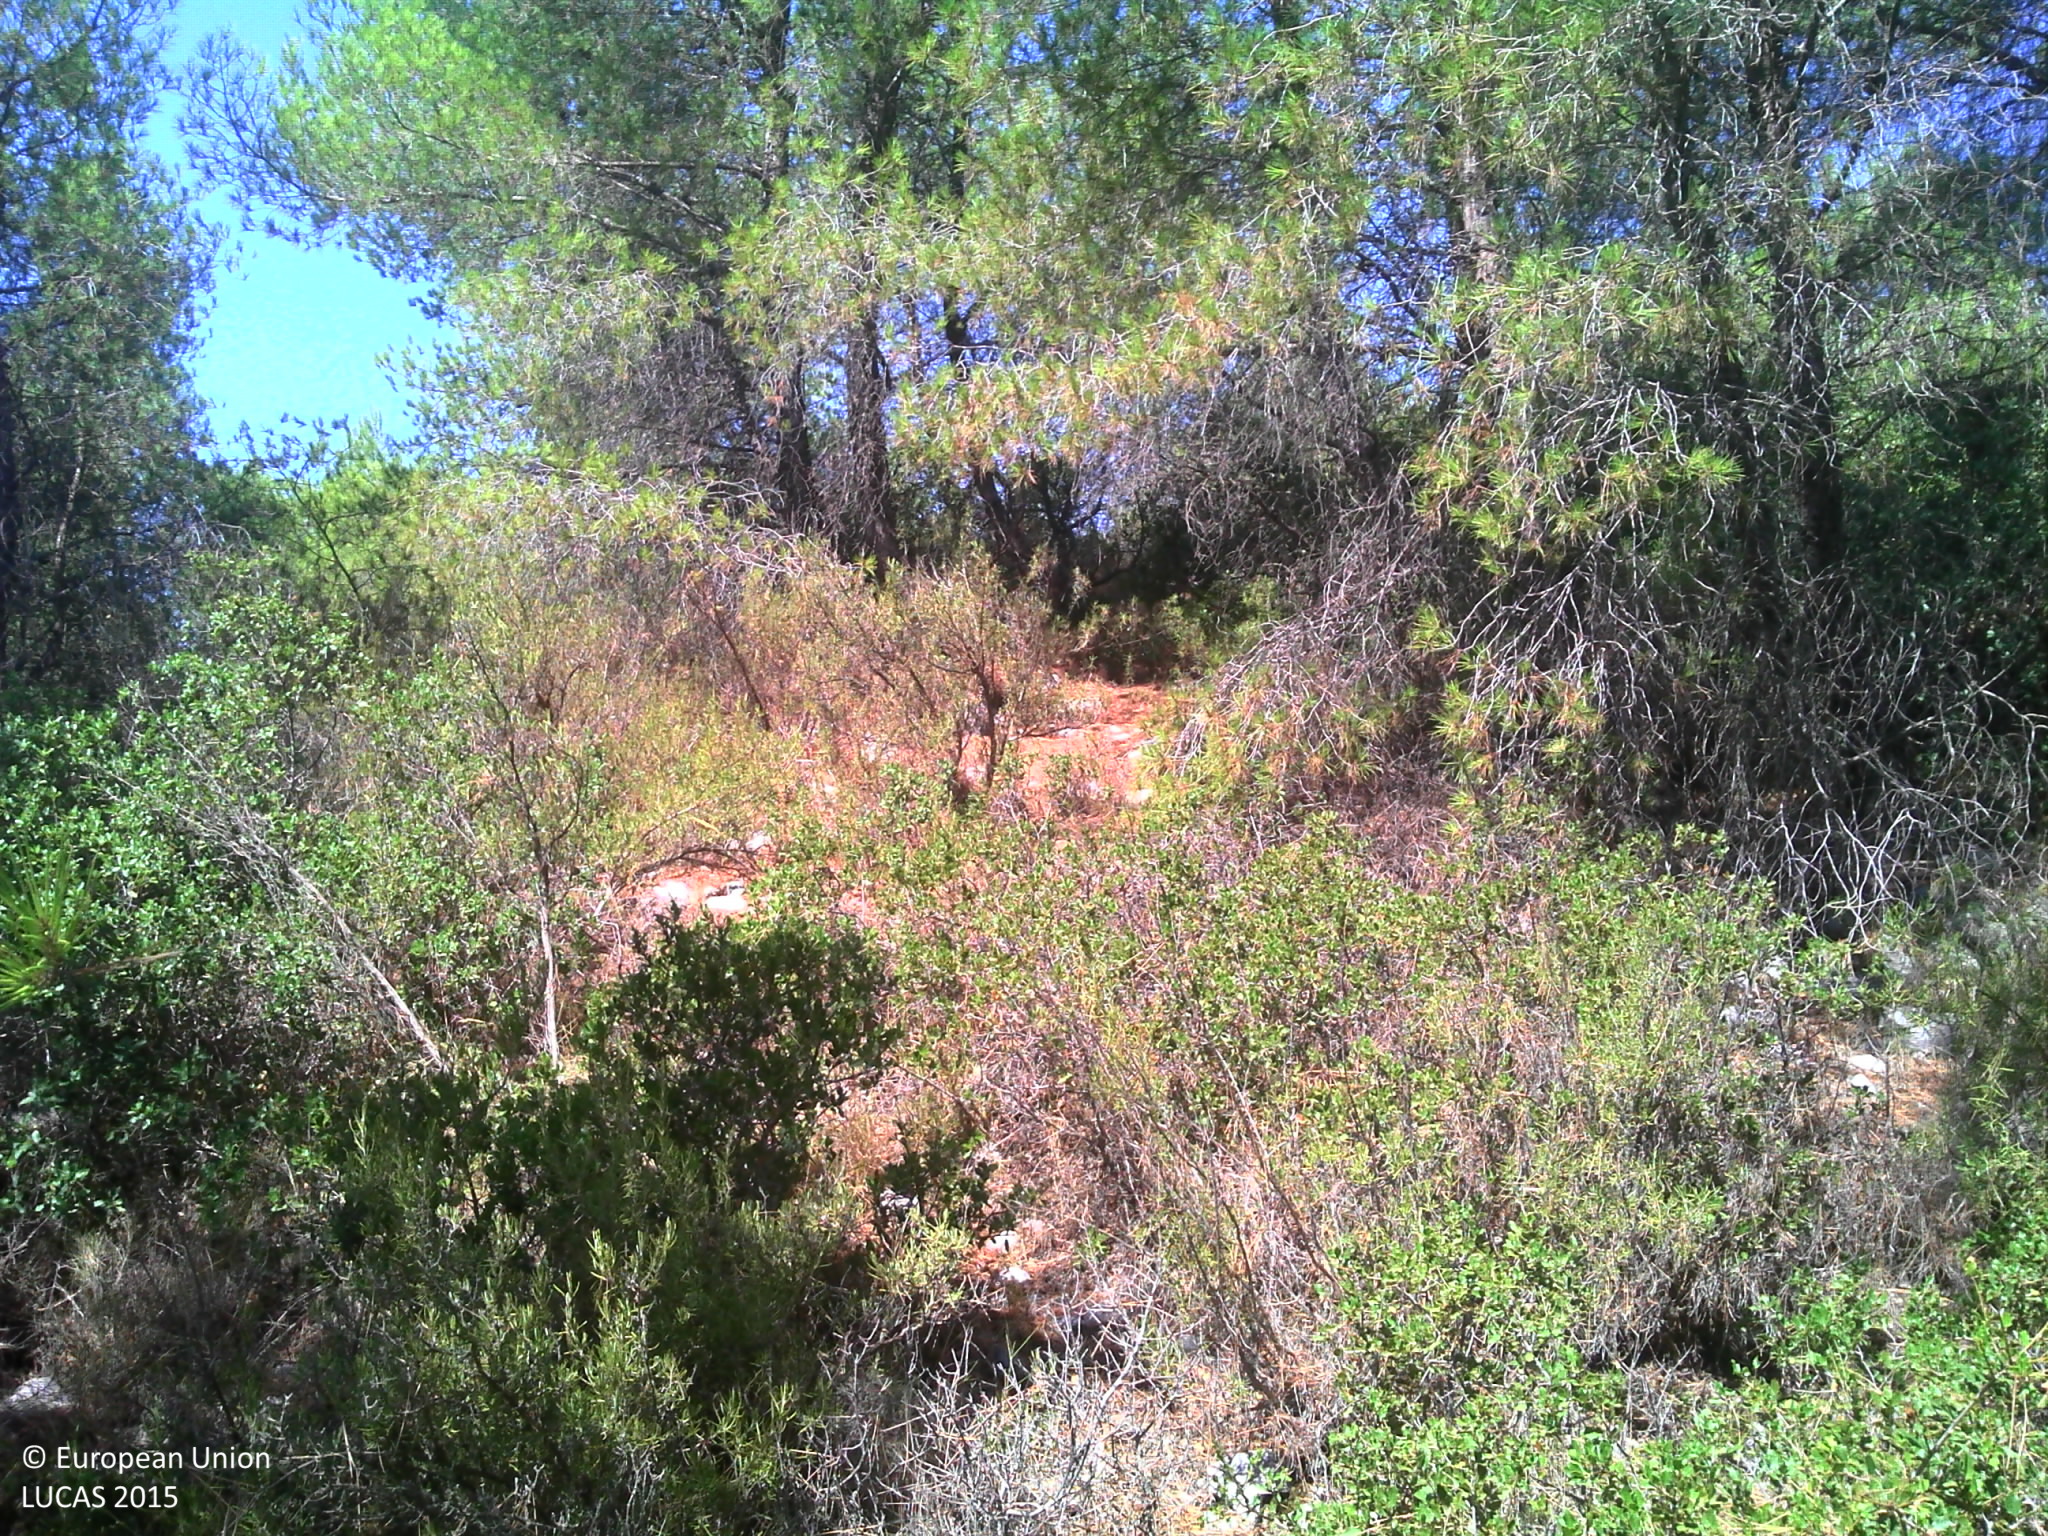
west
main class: Woodland
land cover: Pine dominated coniferous woodland
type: coniferous forest of the mediterranean region
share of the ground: > 75 %
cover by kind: coniferous forest trees 45 %, shrubs 25 %, consolidated bare surface 20 %, herbaceous plants 10 %
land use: Forestry
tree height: > 5 m
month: August
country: FR
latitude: 43.3679
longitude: 5.1111
